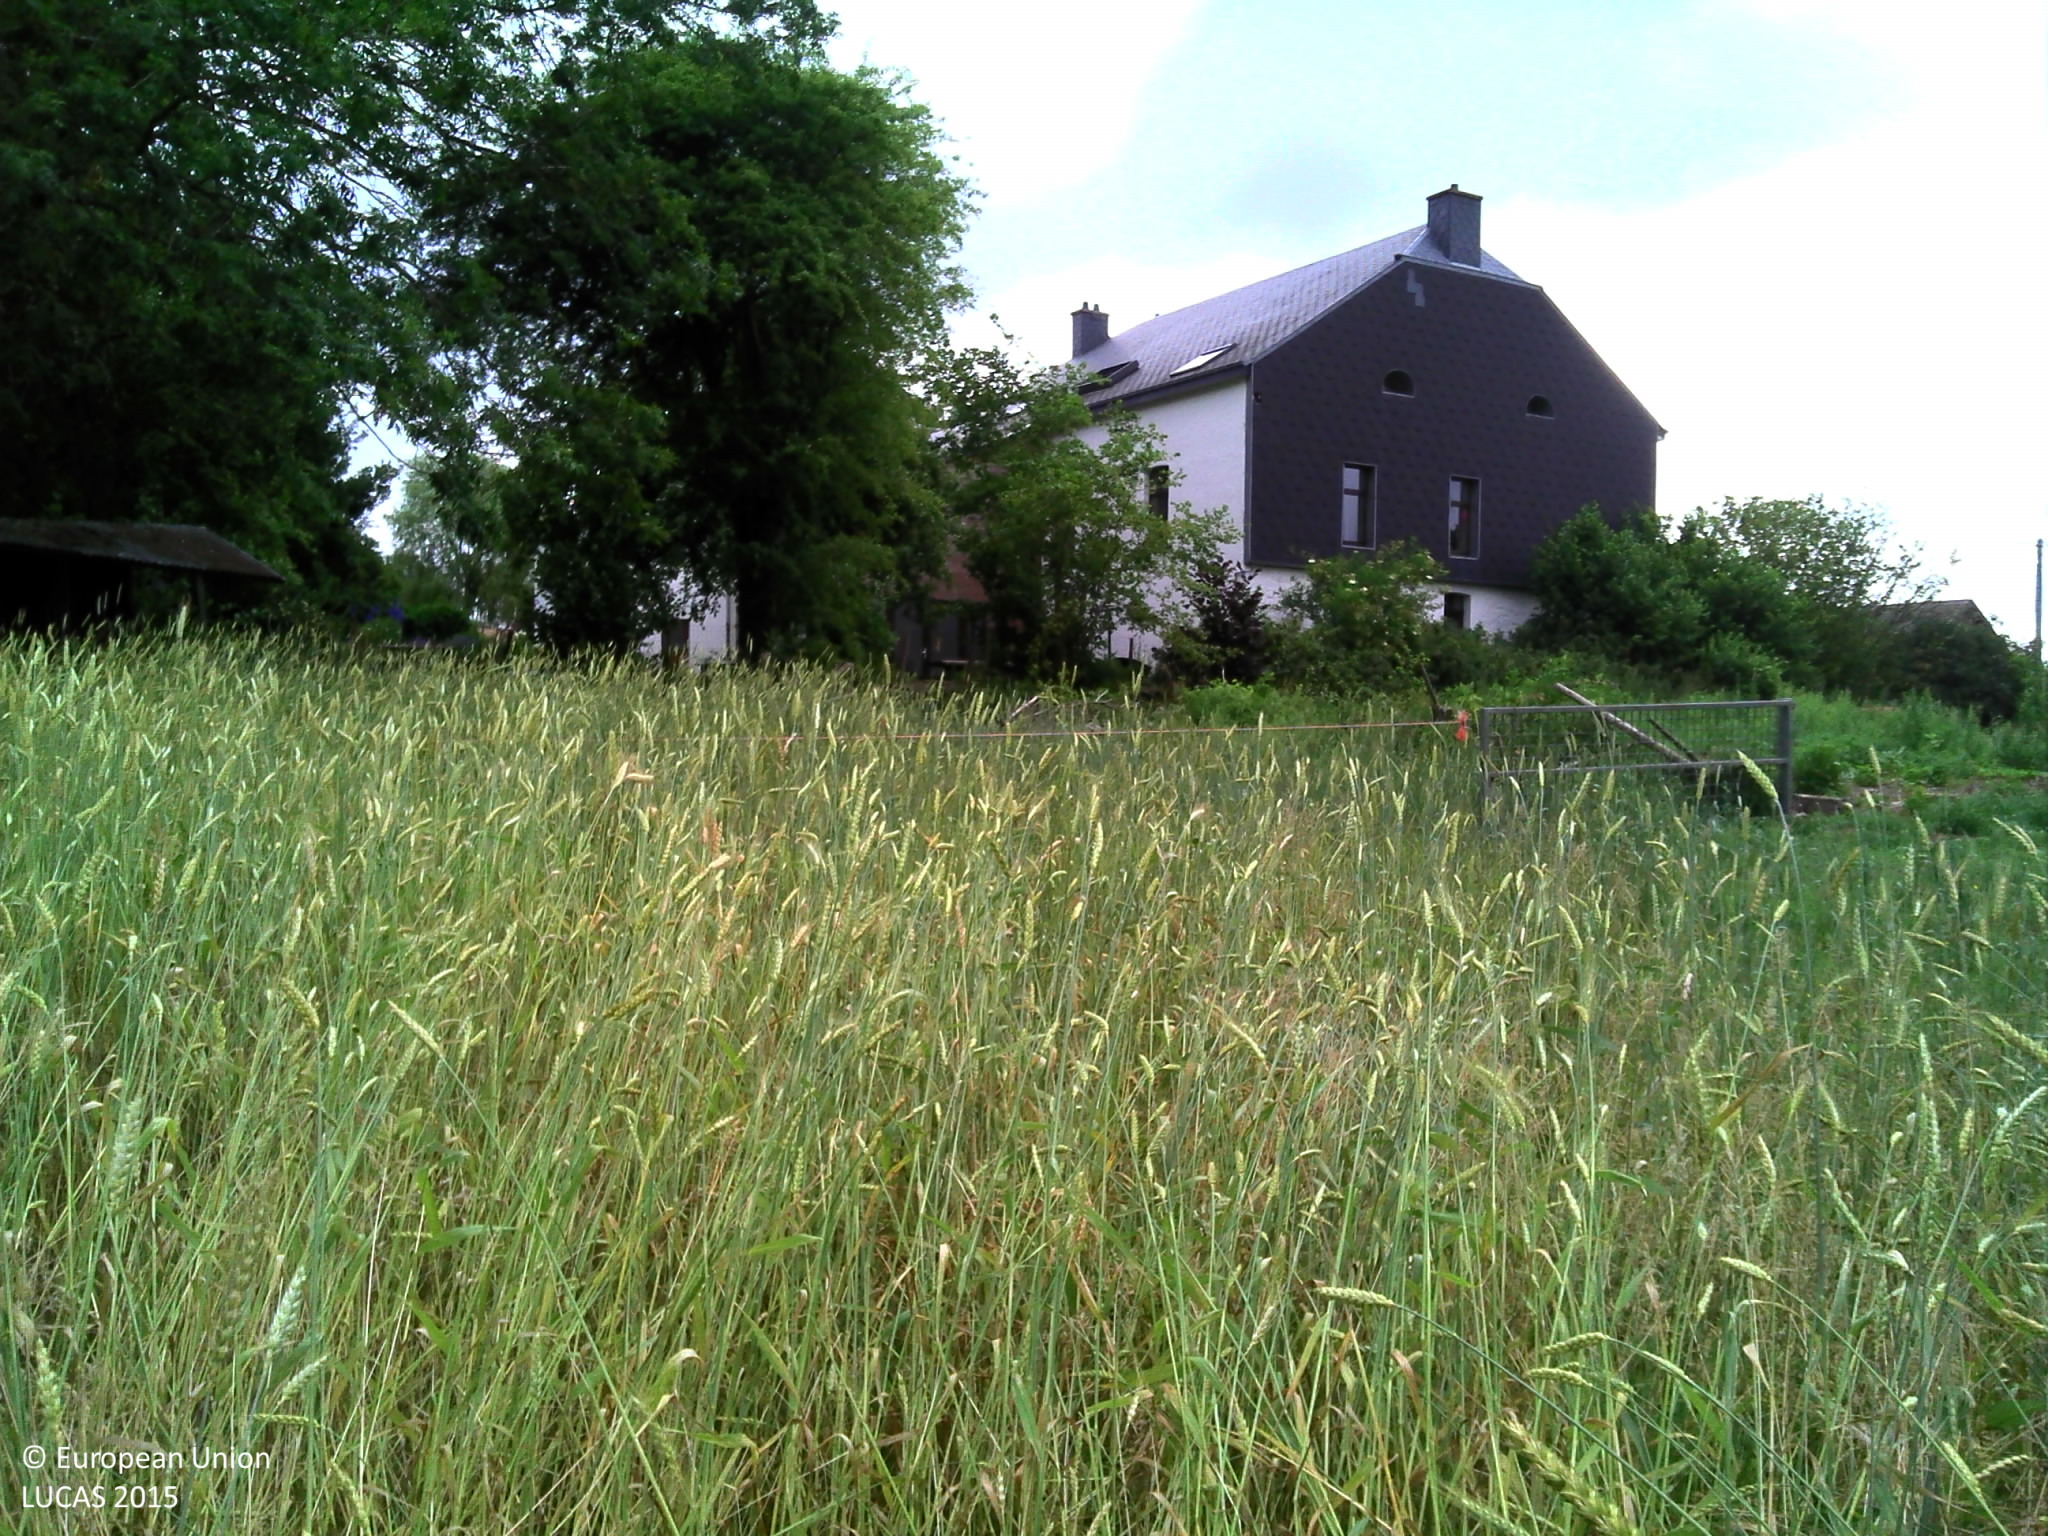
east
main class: Cropland
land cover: Mixed cereals for fodder
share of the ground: > 75 %
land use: Agriculture (excluding fallow land and kitchen gardens)
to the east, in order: Mixed cereals for fodder; Fences; Mixed cereals for fodder; Artificial constructions in urban areas; Managed hedges; Fences; Grassland without tree/shrub cover; Broadleaved woodland; Artificial constructions in urban areas; Grassland without tree/shrub cover; Fences; Spontaneously vegetated surfaces; Artificial constructions in urban areas
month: July
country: BE
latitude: 50.1814
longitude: 5.8677
